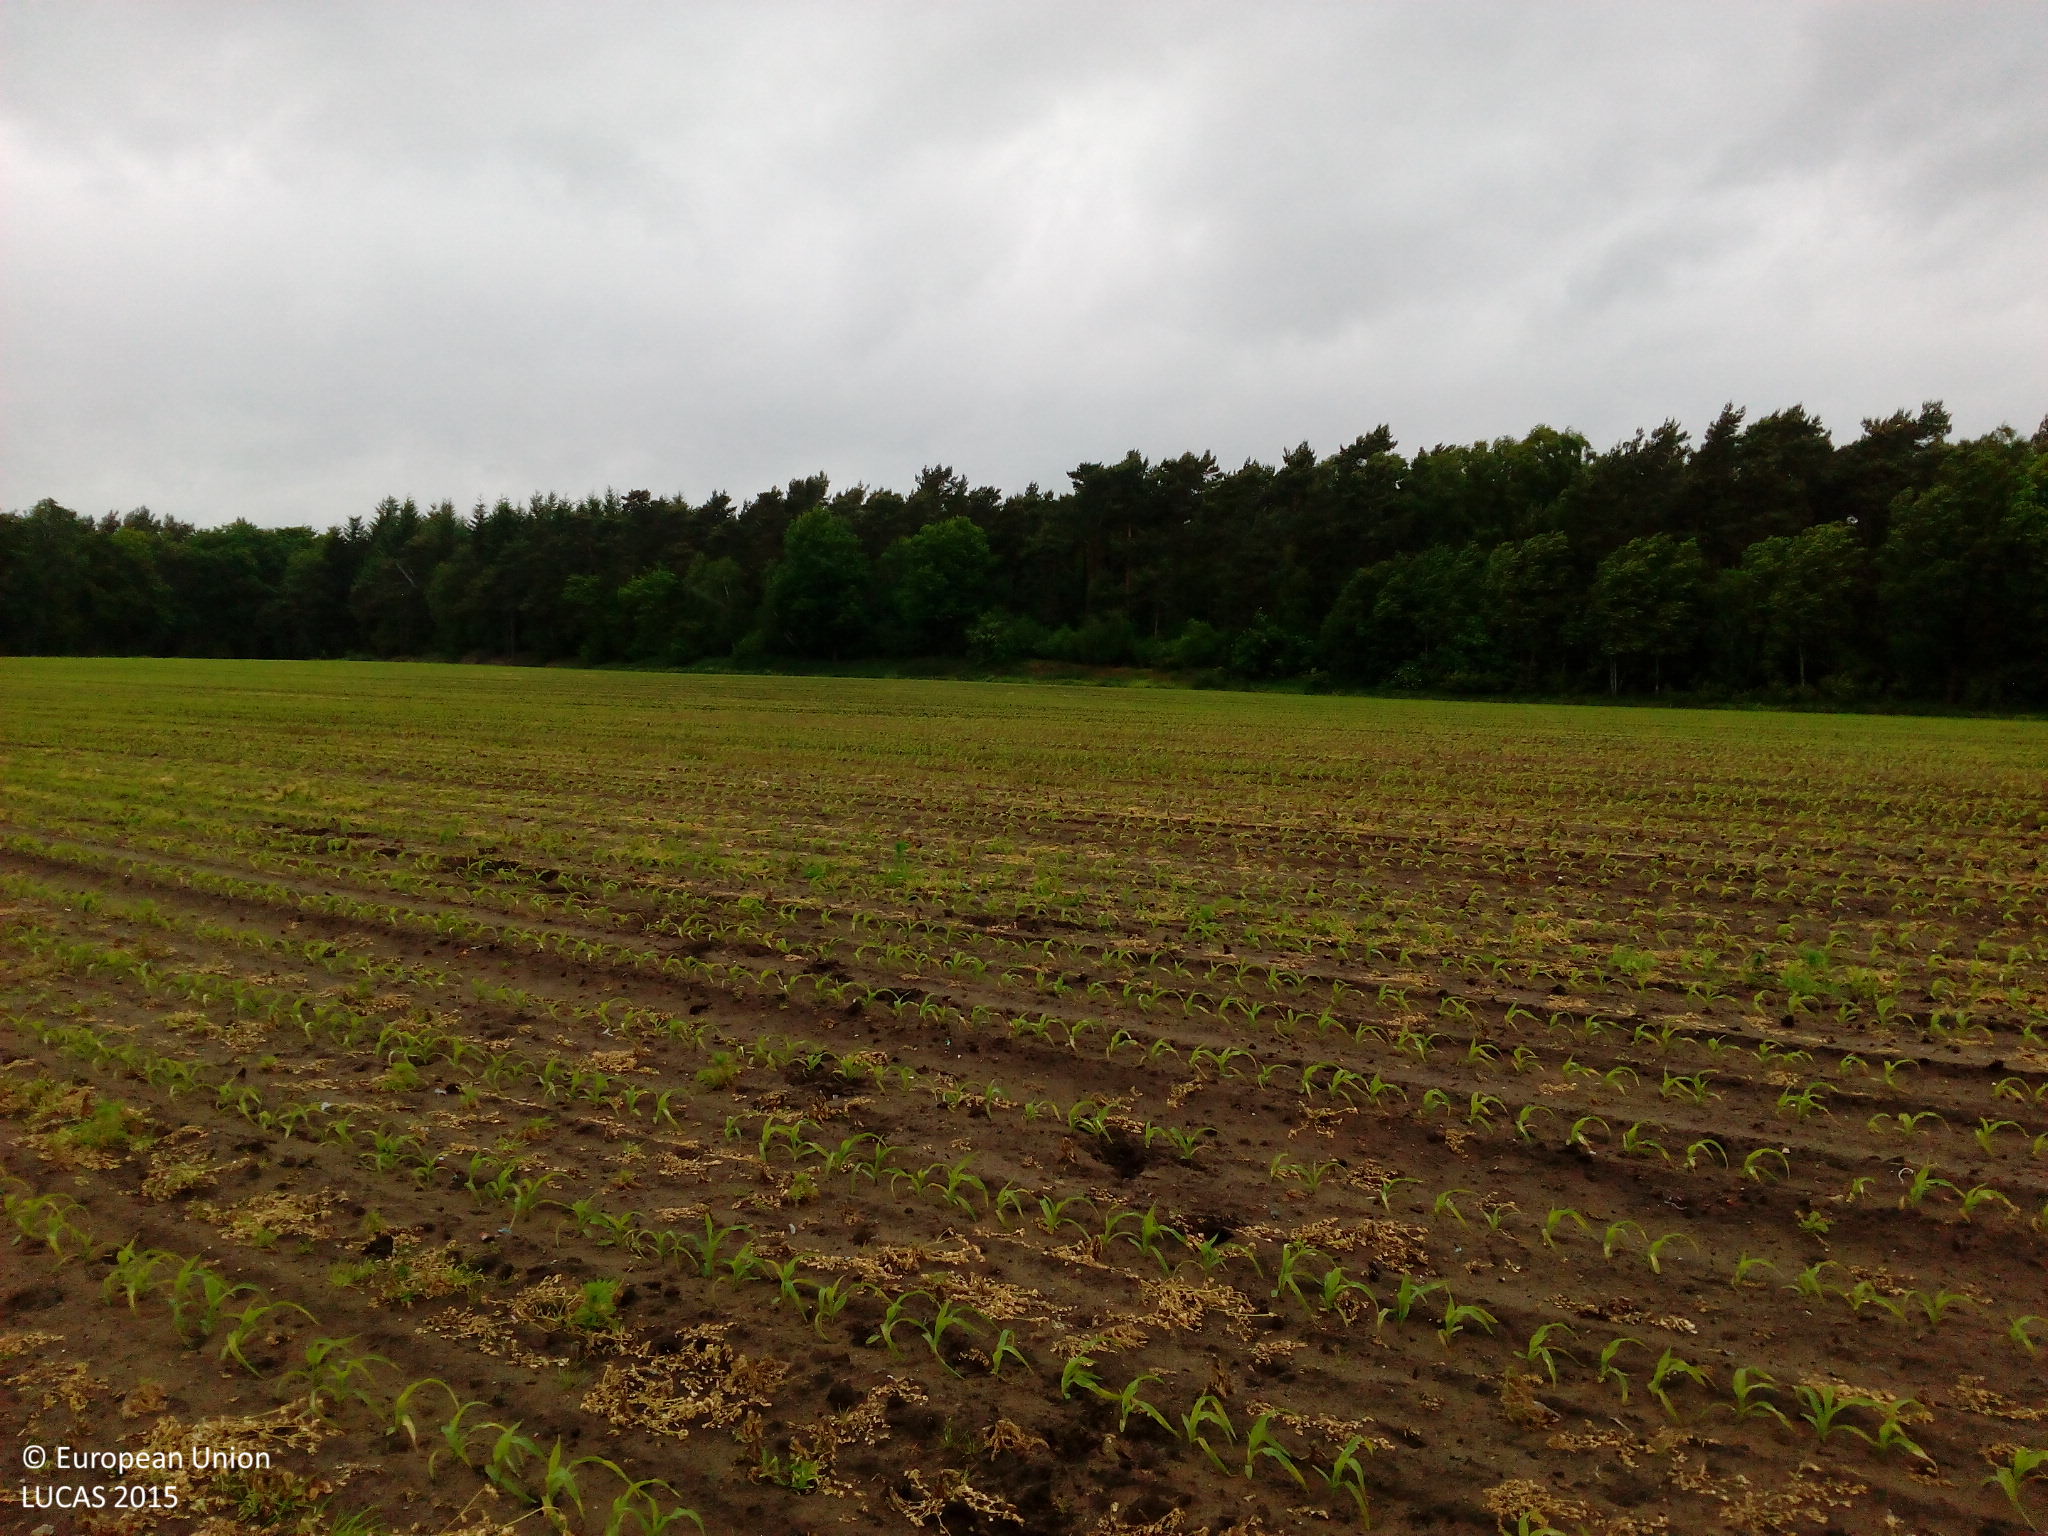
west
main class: Cropland
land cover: Maize
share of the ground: > 75 %
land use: Agriculture (excluding fallow land and kitchen gardens)
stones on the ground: < 10 %
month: June
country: DE
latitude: 52.3484
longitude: 7.3726
